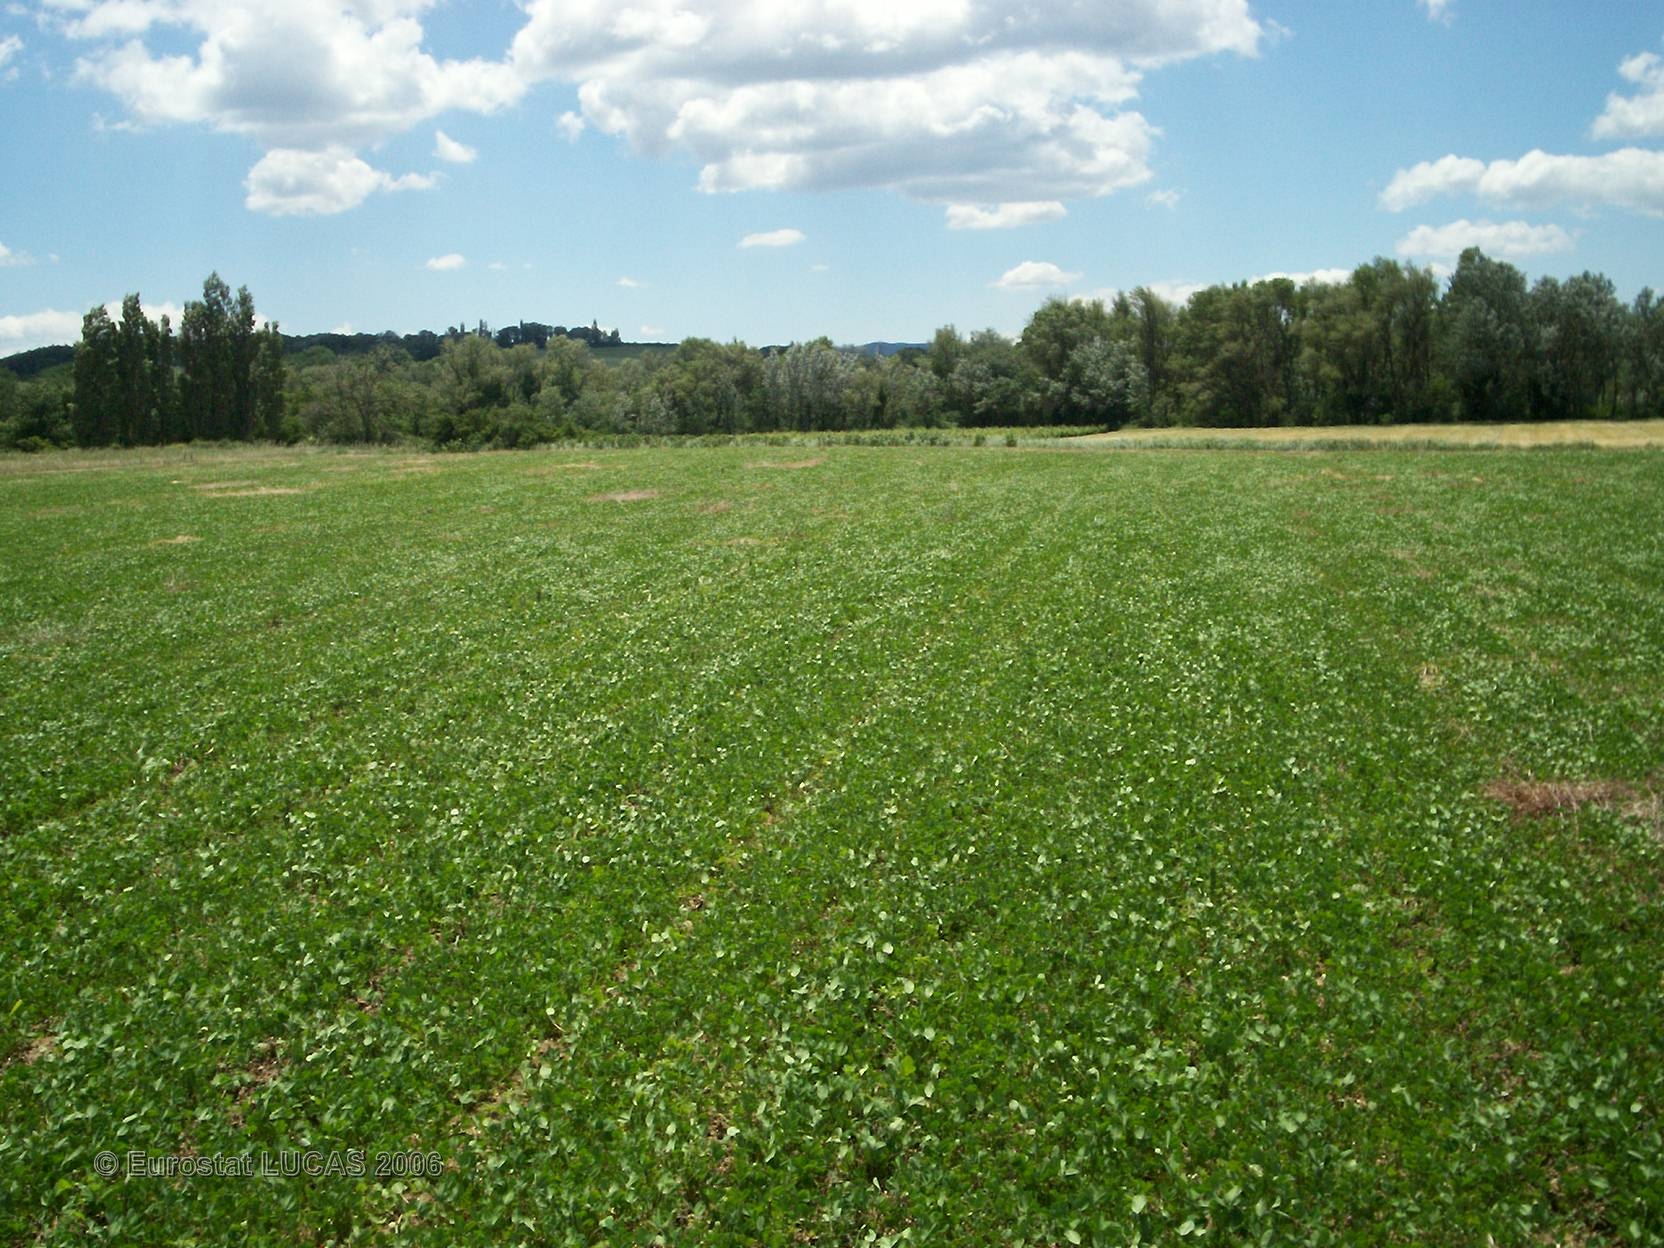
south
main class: Cropland
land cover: Clovers
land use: Agriculture (excluding fallow land and kitchen gardens)
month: May
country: FR
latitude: 44.5868
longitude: 4.9054
